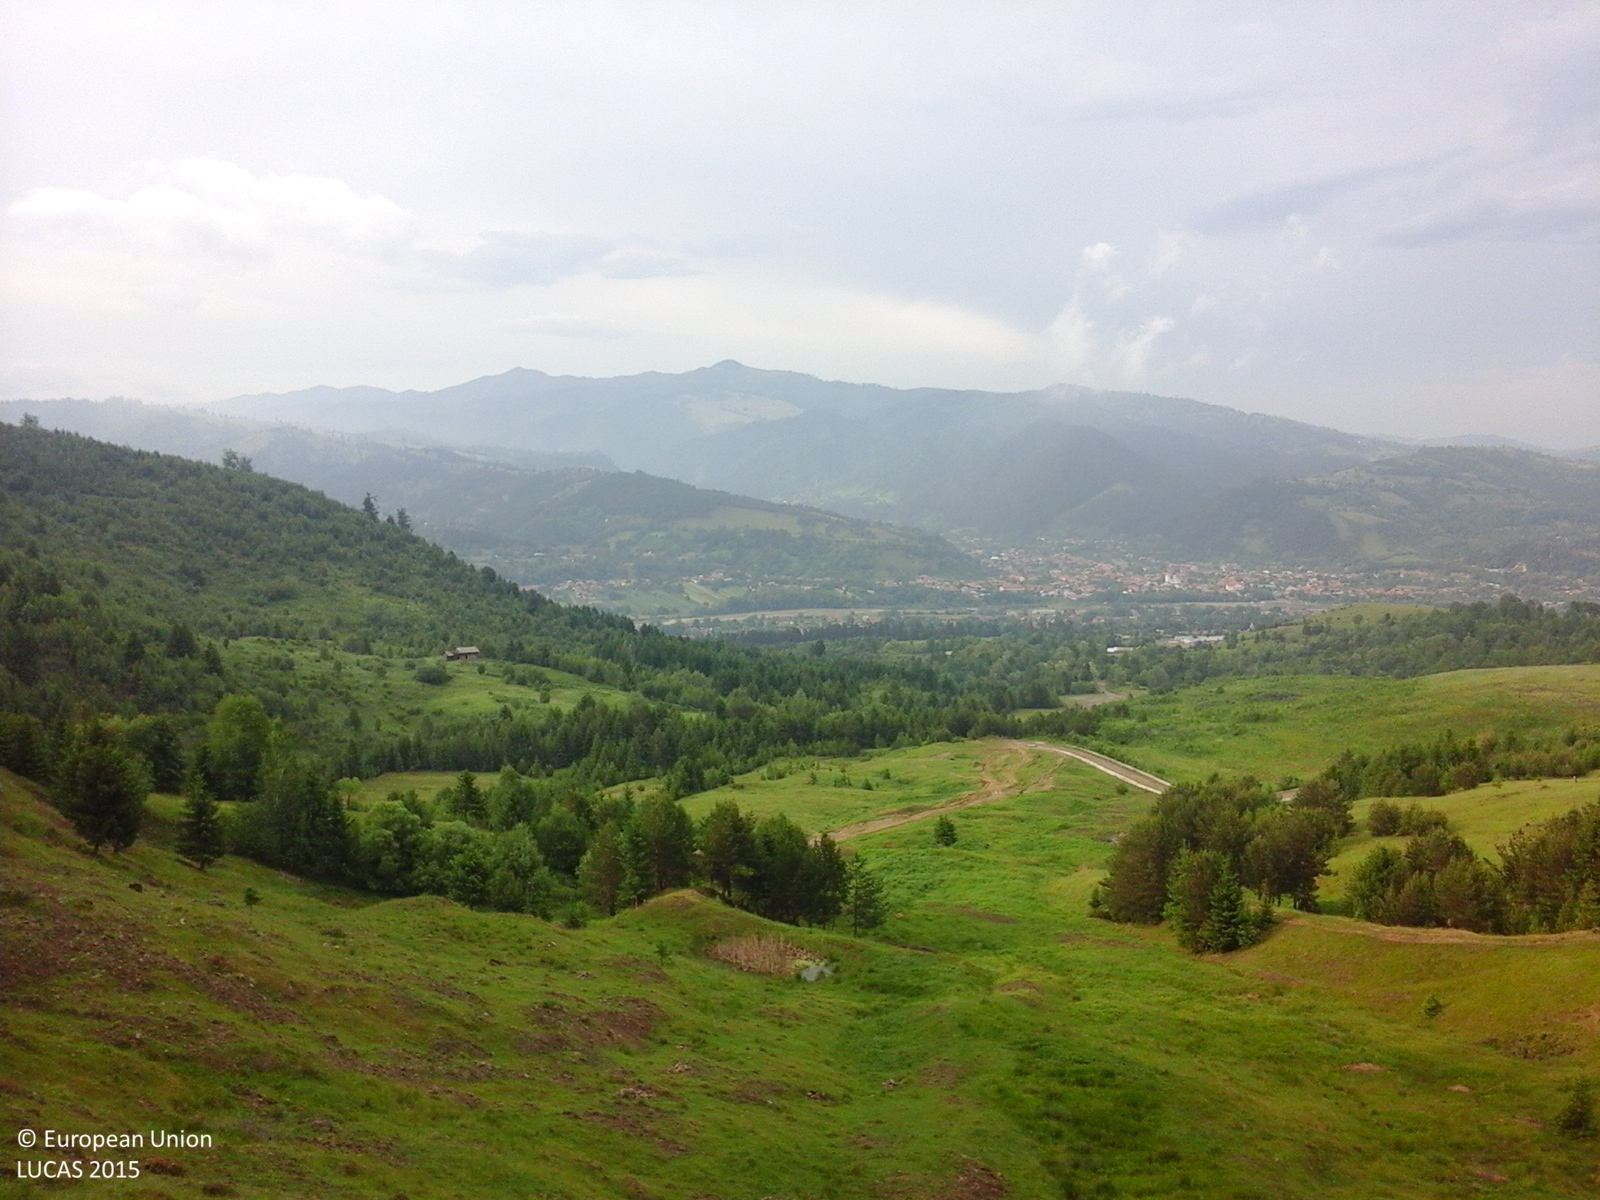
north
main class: Grassland
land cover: Grassland with sparse tree/shrub cover
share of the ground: > 75 %
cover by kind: herbaceous plants 95 %, coniferous forest trees 5 %
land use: Agriculture (excluding fallow land and kitchen gardens)
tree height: > 5 m
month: June
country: RO
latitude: 46.4179
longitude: 26.3806
